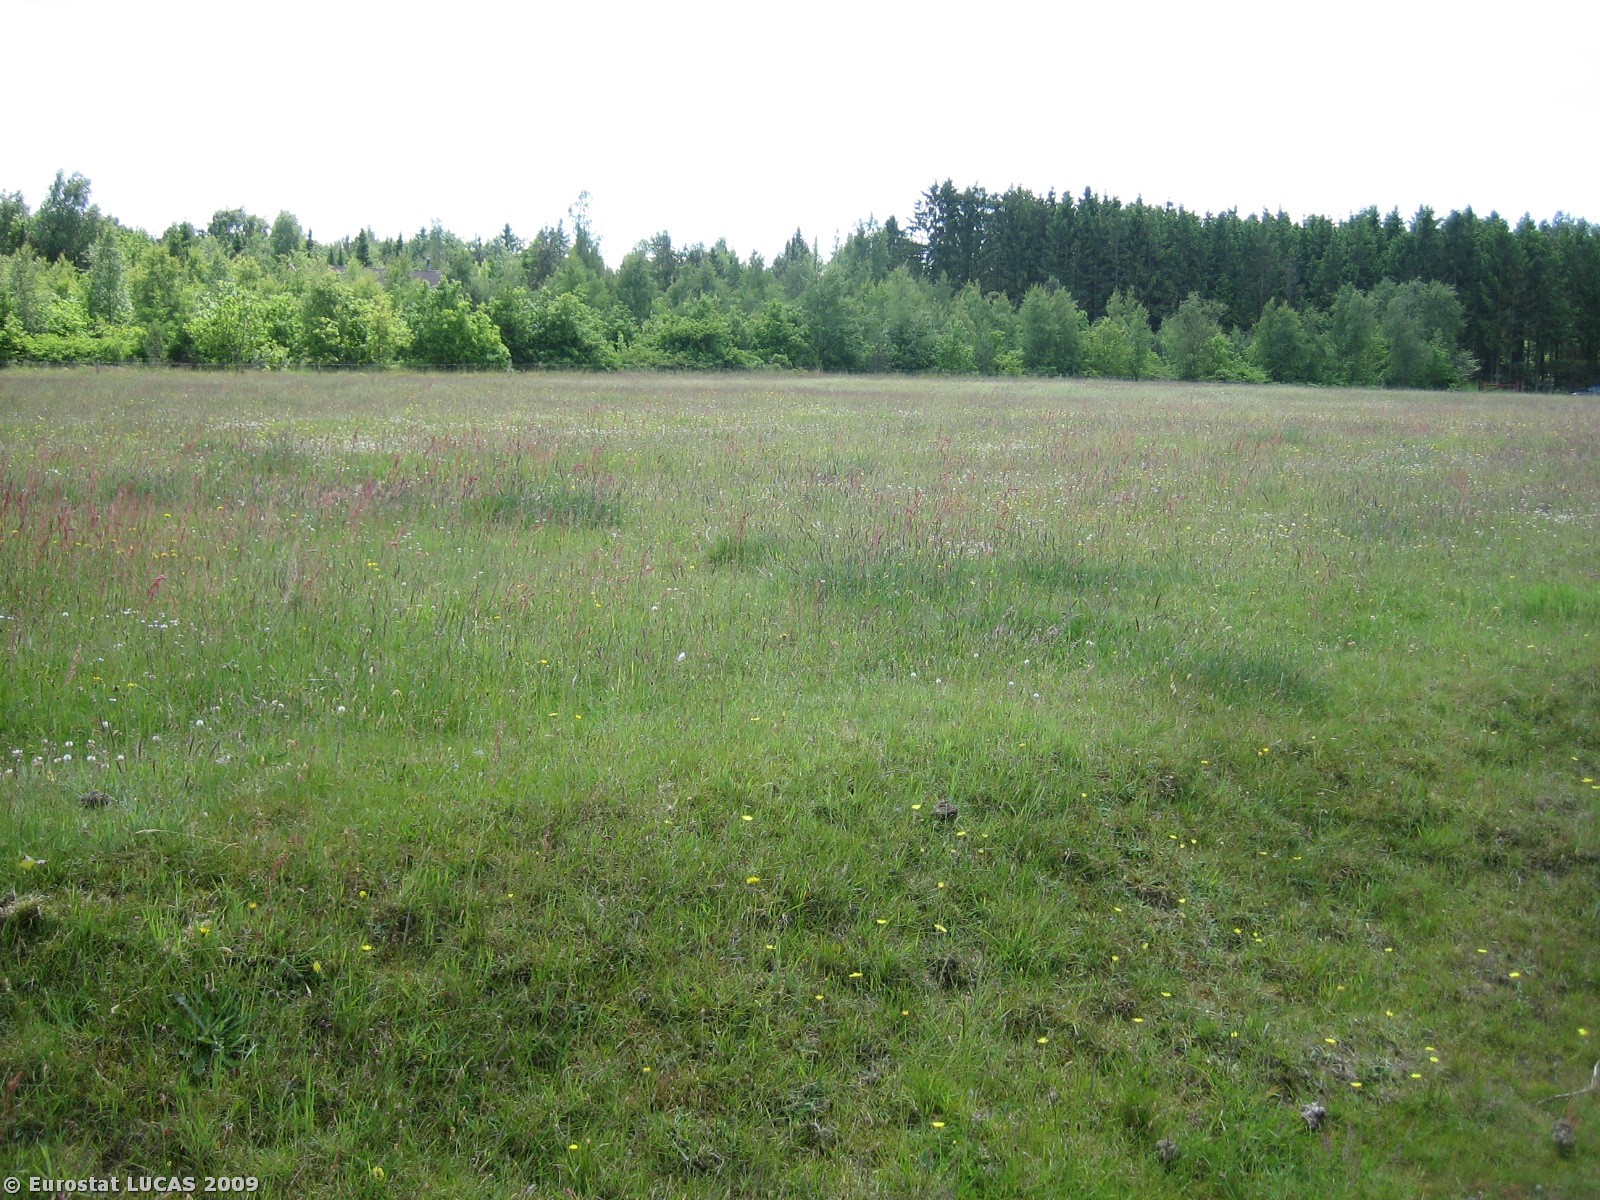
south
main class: Woodland
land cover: Broadleaved woodland
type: mesophytic deciduous forest
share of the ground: > 75 %
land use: Forestry
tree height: > 5 m
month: June
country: DK
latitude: 56.0616
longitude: 9.7273
